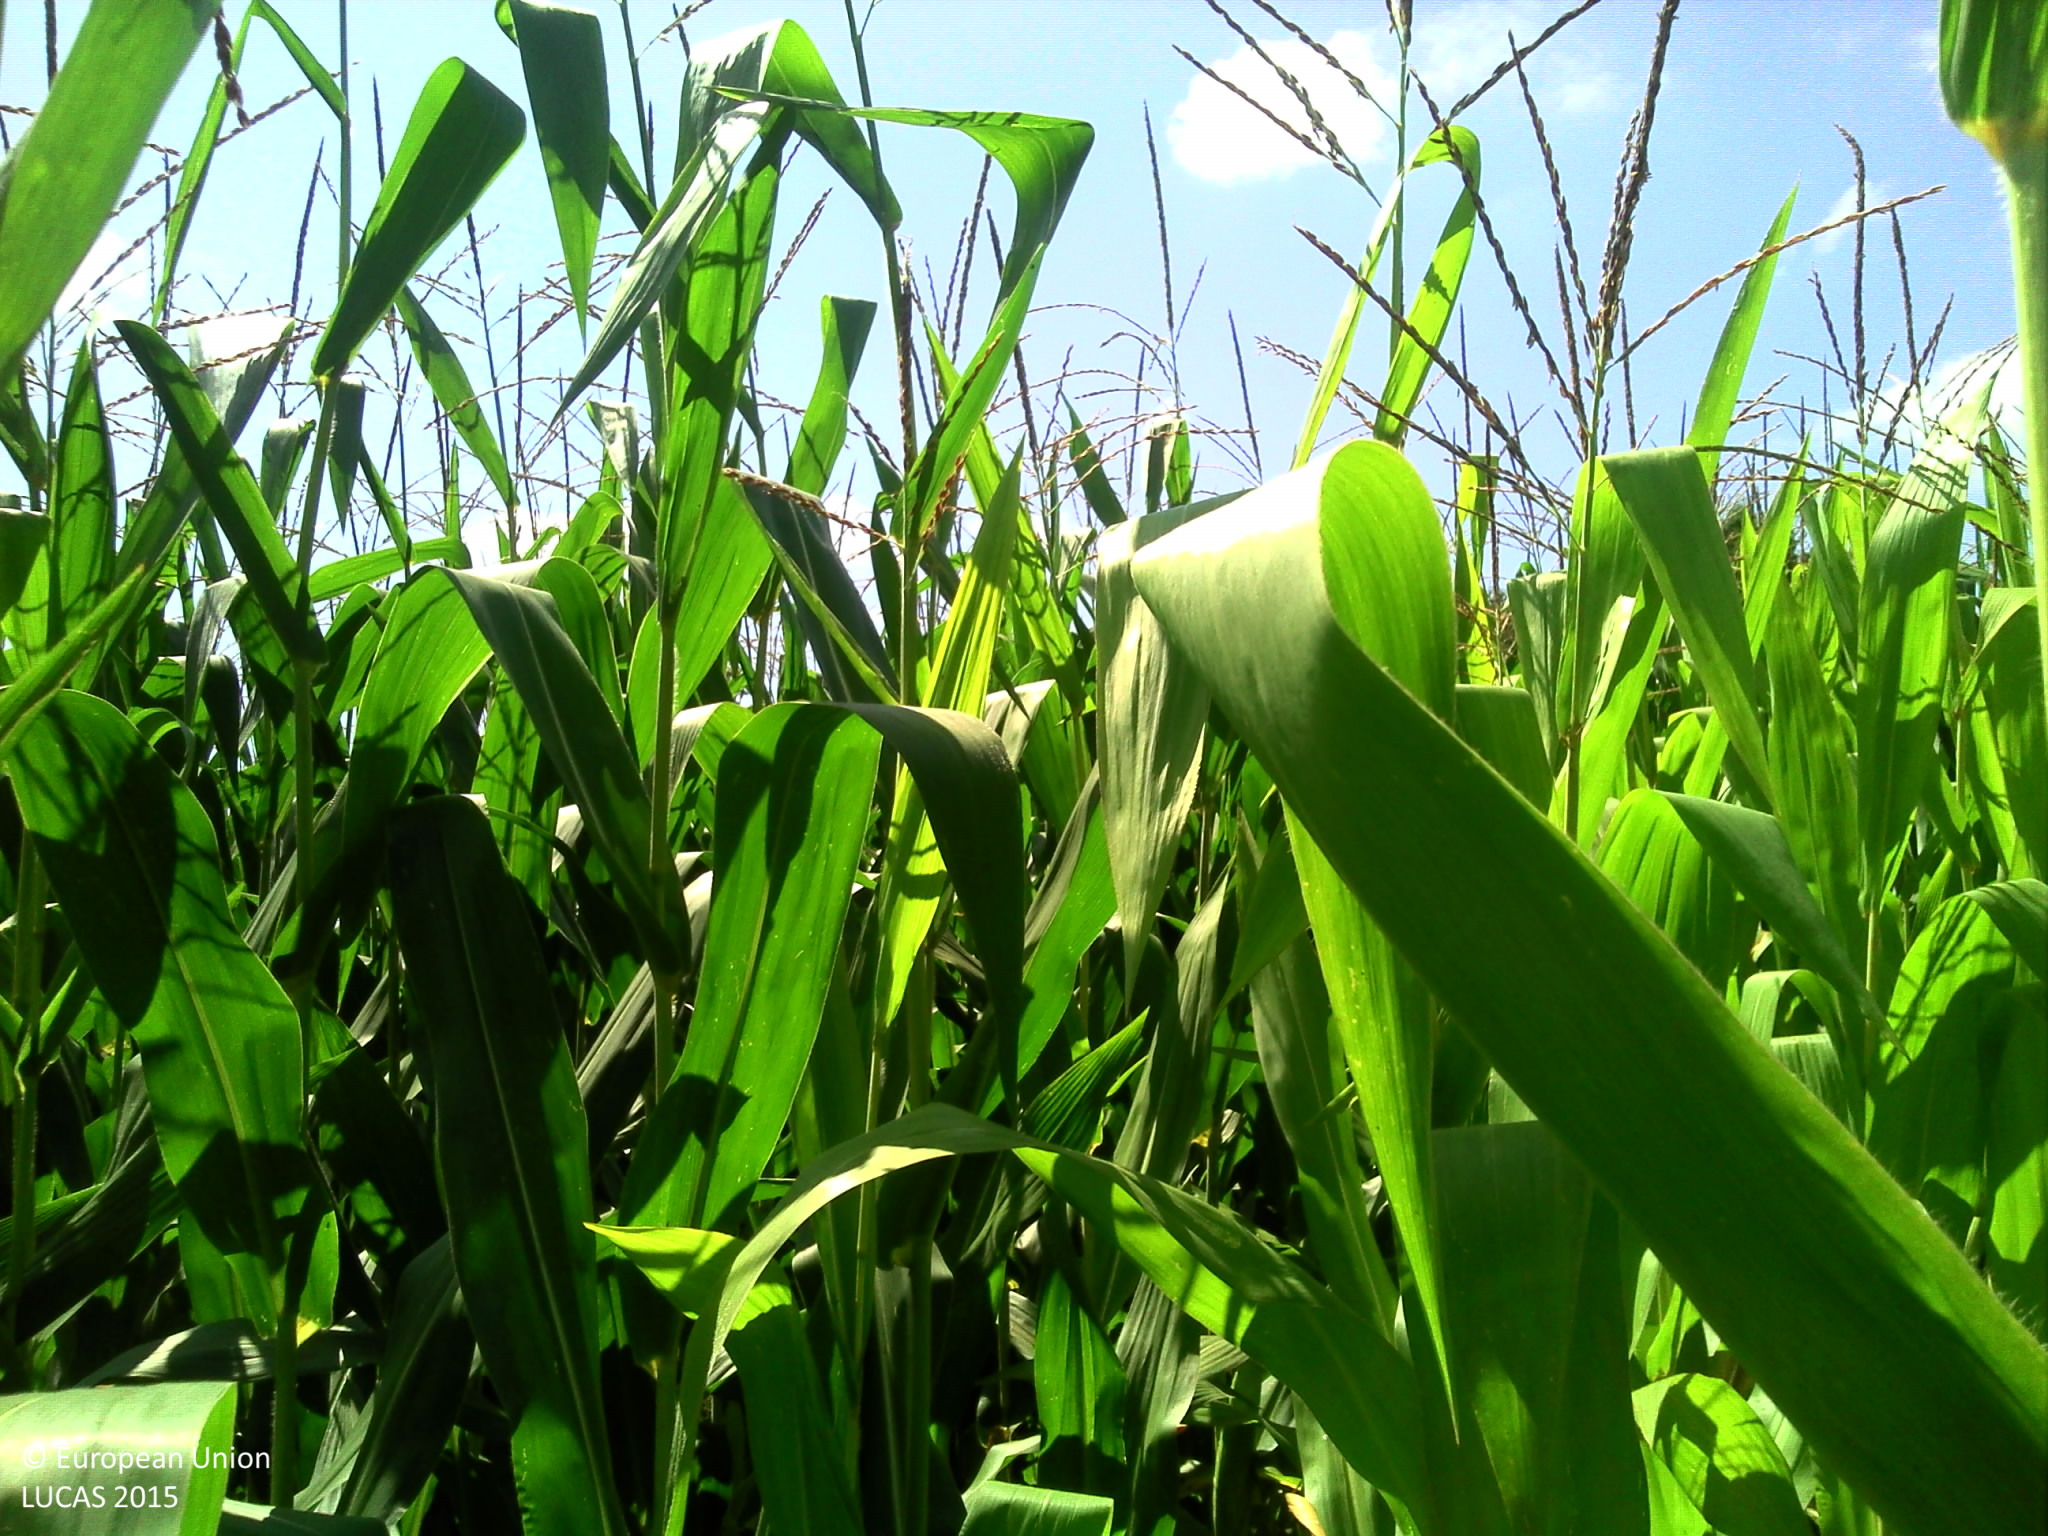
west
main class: Cropland
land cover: Maize
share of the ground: > 75 %
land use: Agriculture (excluding fallow land and kitchen gardens)
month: July
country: FR
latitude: 43.5662
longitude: -1.1461
